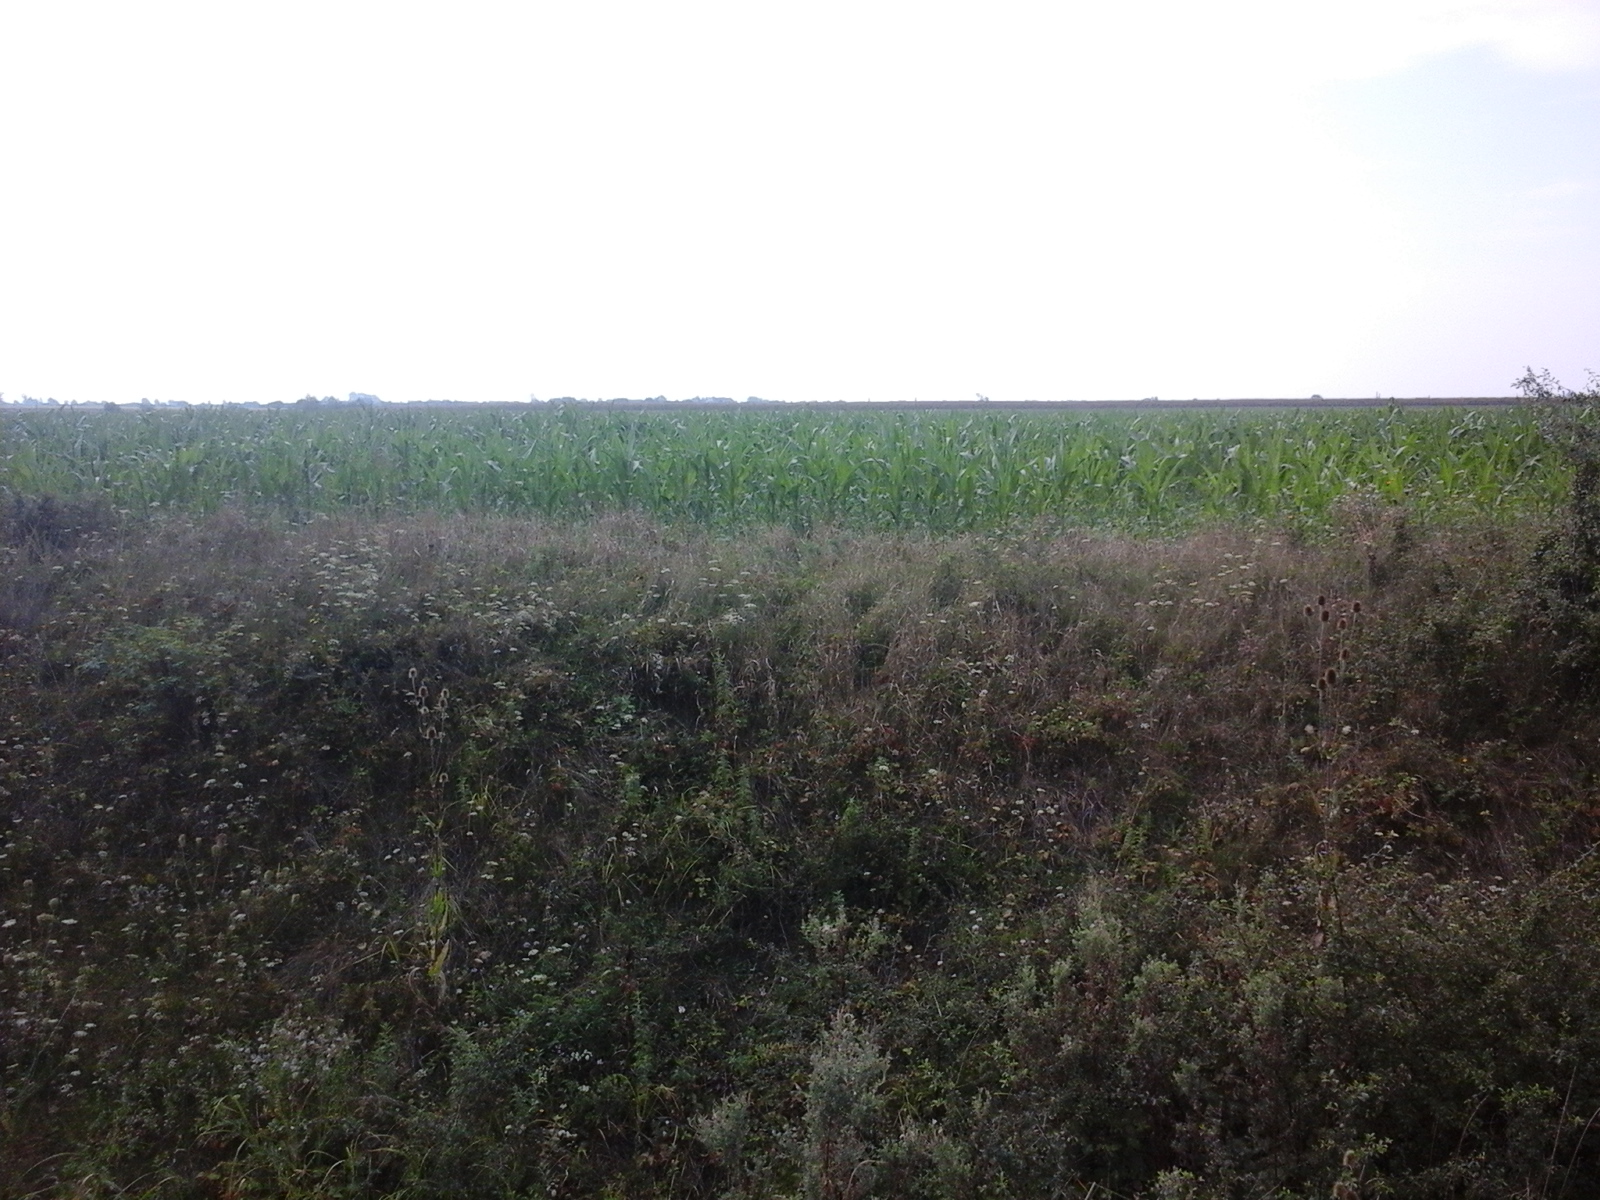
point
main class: Cropland
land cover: Maize
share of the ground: > 75 %
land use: Agriculture (excluding fallow land and kitchen gardens)
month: August
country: RO
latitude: 46.7899
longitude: 21.6079
